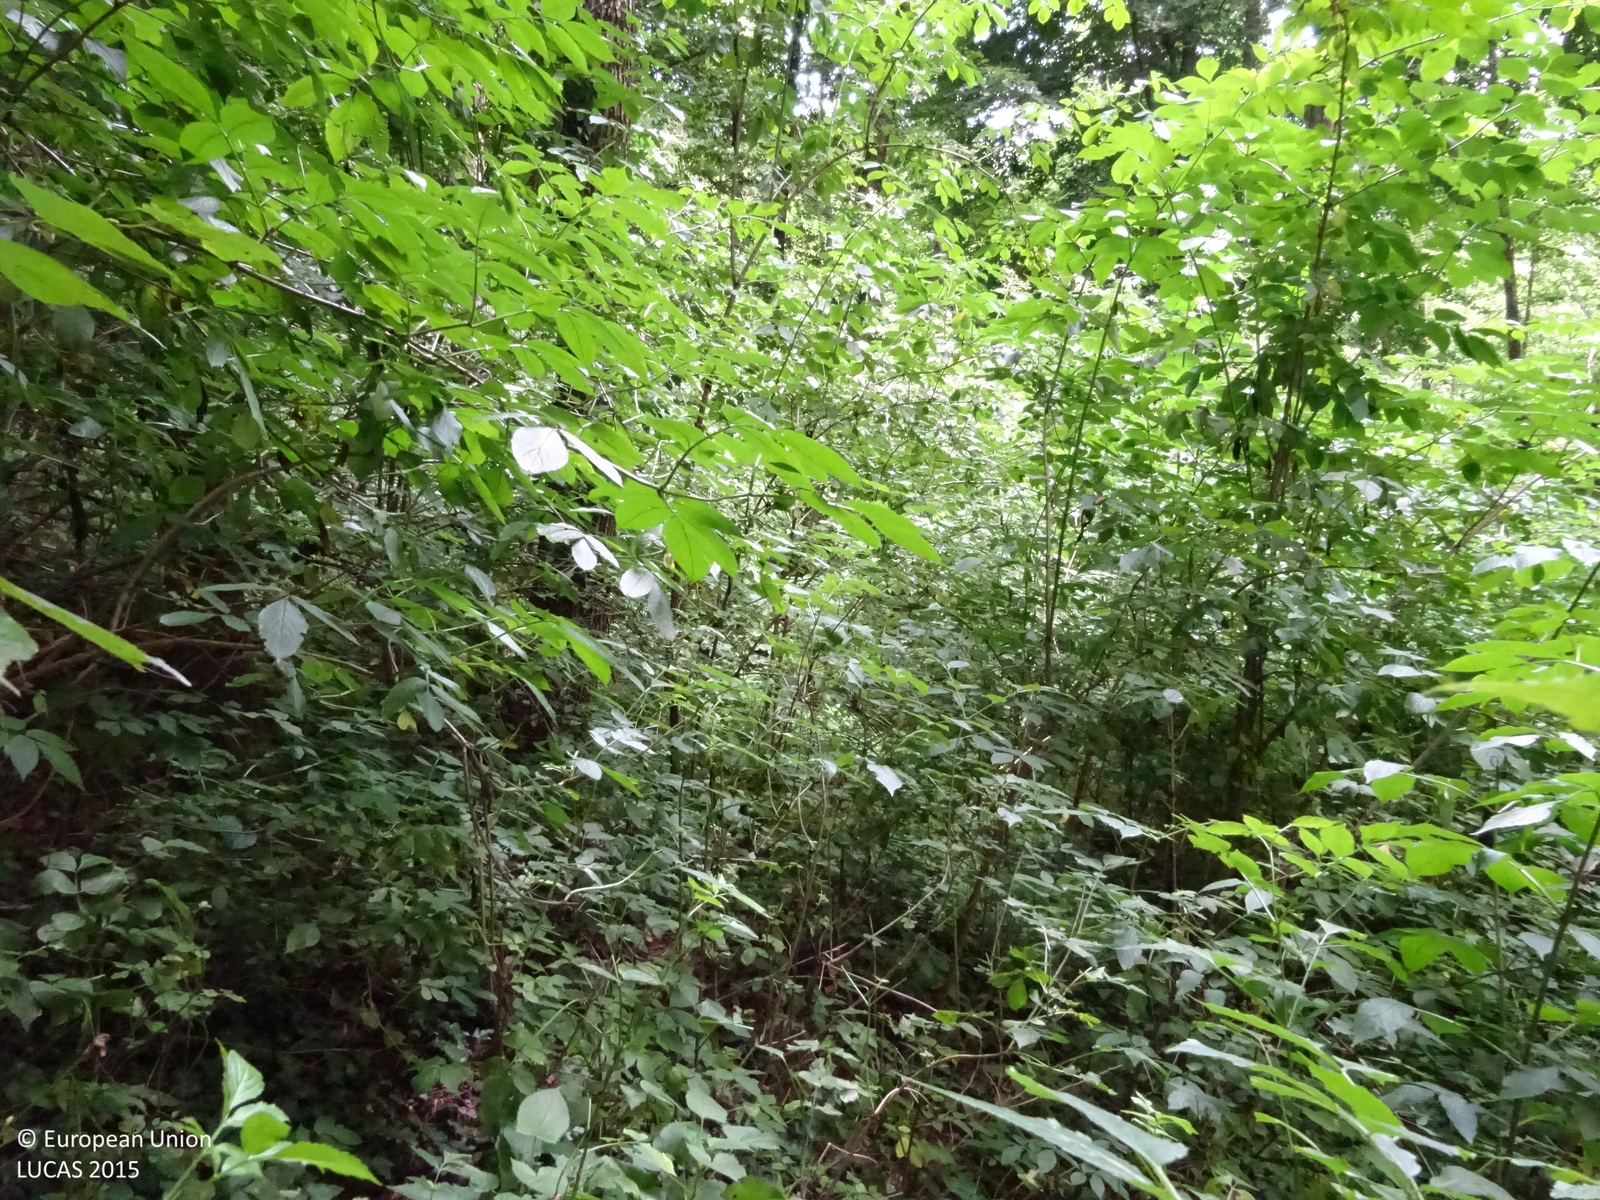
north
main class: Woodland
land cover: Spruce dominated mixed woodland
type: mountainous beech forest
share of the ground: > 75 %
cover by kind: broadleaved forest trees 65 %, coniferous forest trees 25 %, shrubs 10 %
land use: Forestry
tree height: > 5 m
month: July
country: AT
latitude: 46.9273
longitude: 15.9238
